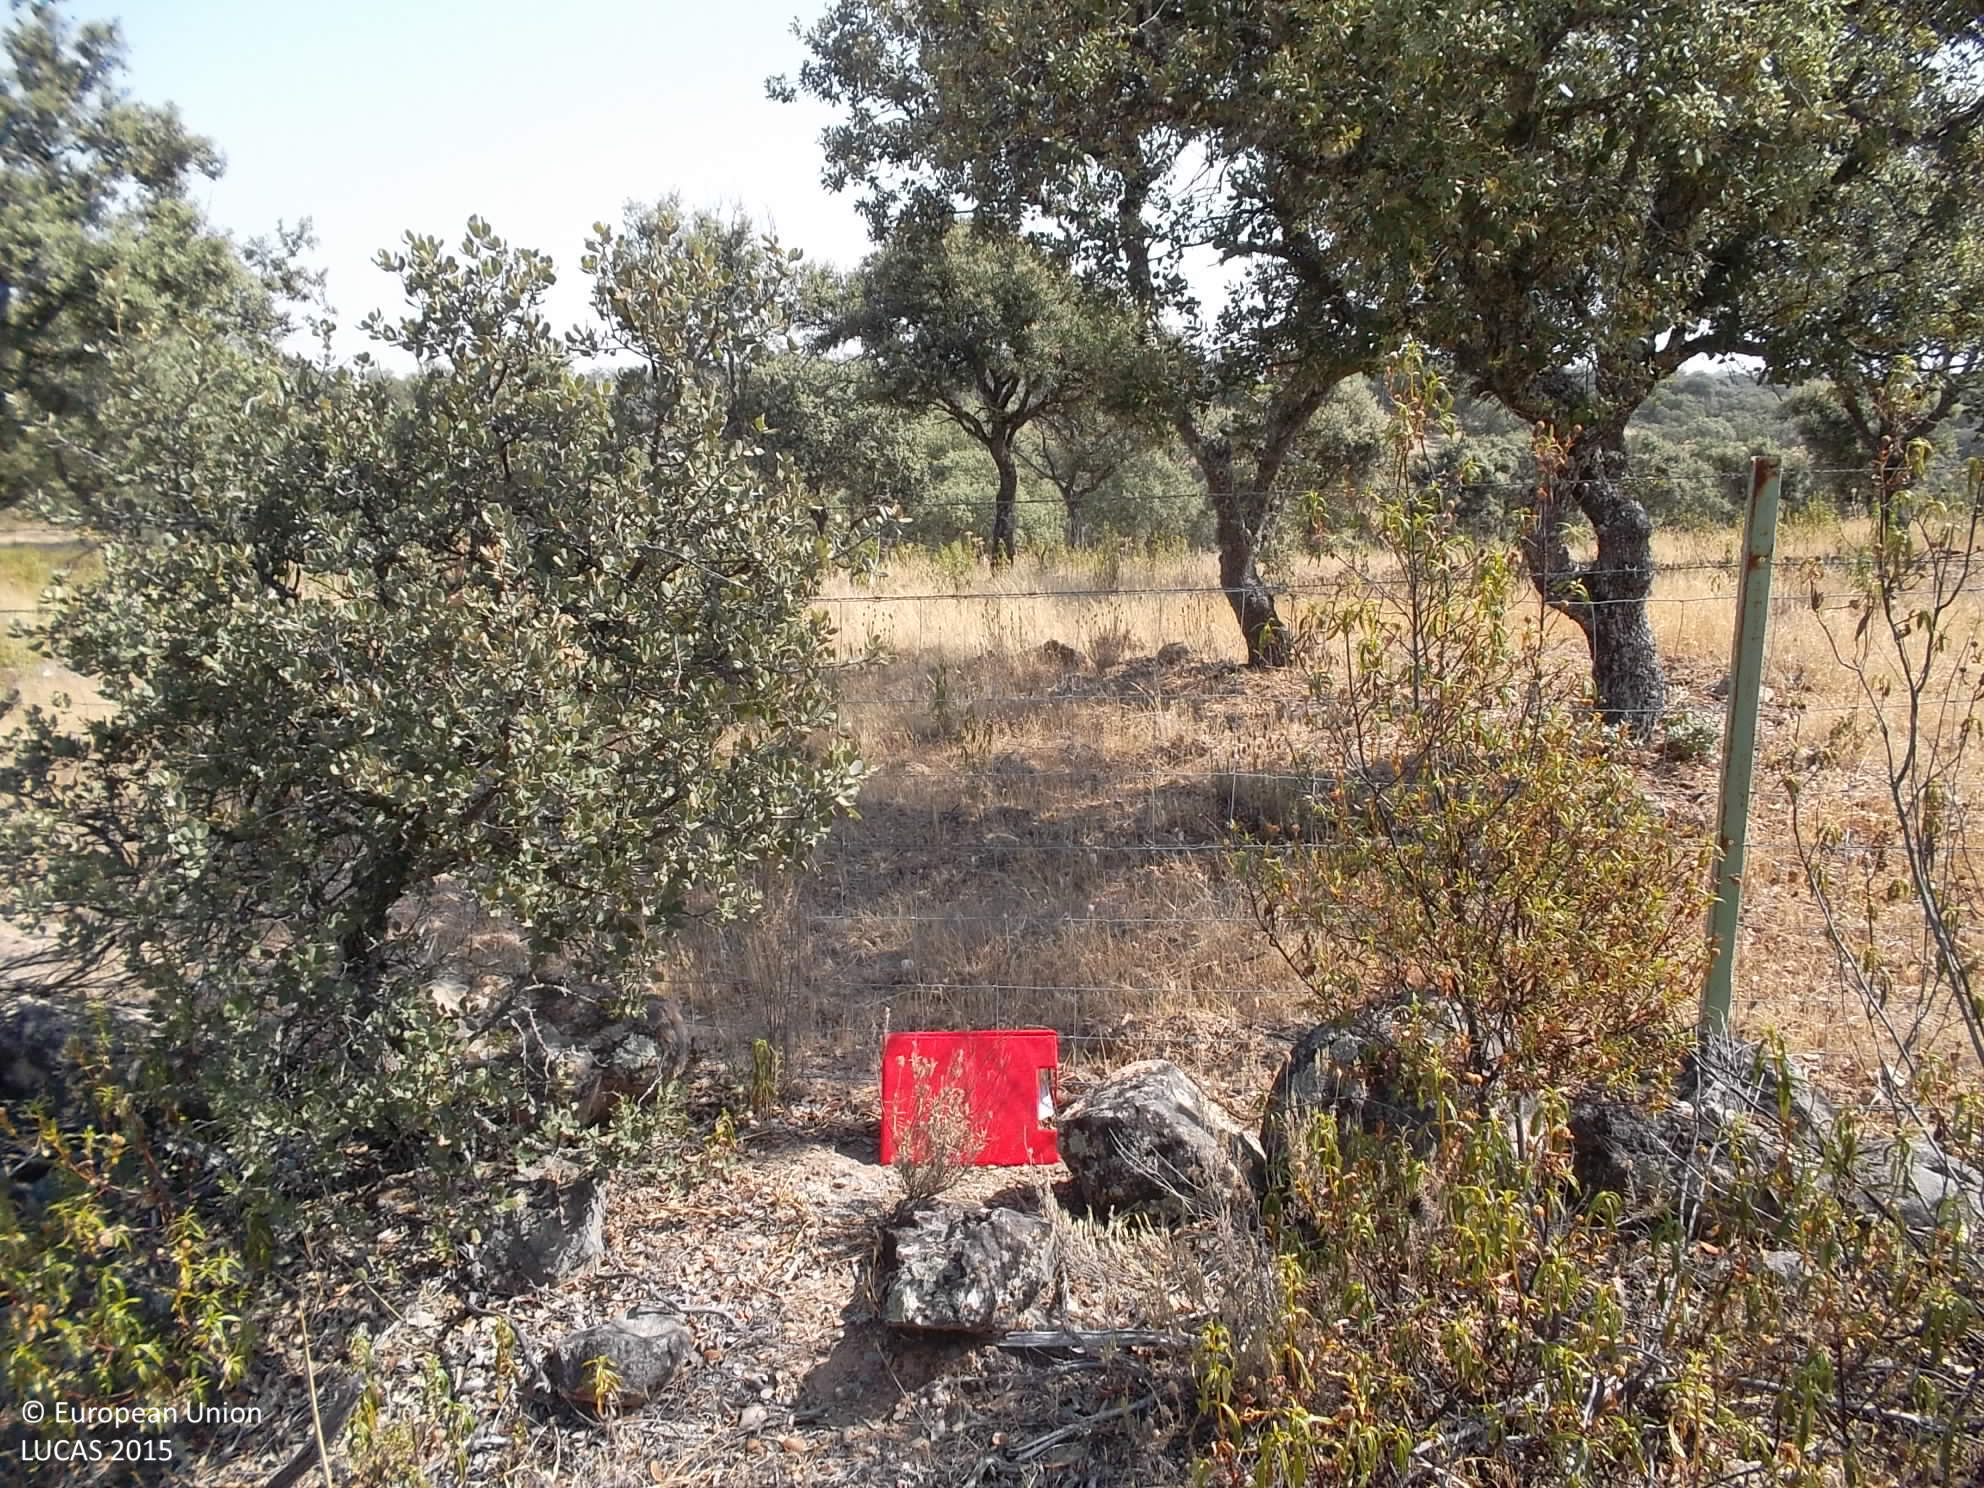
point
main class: Shrubland
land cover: Shrubland with sparse tree cover
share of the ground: 25 - 50 %
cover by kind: herbaceous plants 55 %, shrubs 40 %, broadleaved forest trees 5 %
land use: Semi-natural and natural areas not in use
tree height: < 5 m
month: July
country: ES
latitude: 38.2172
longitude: -4.6957
